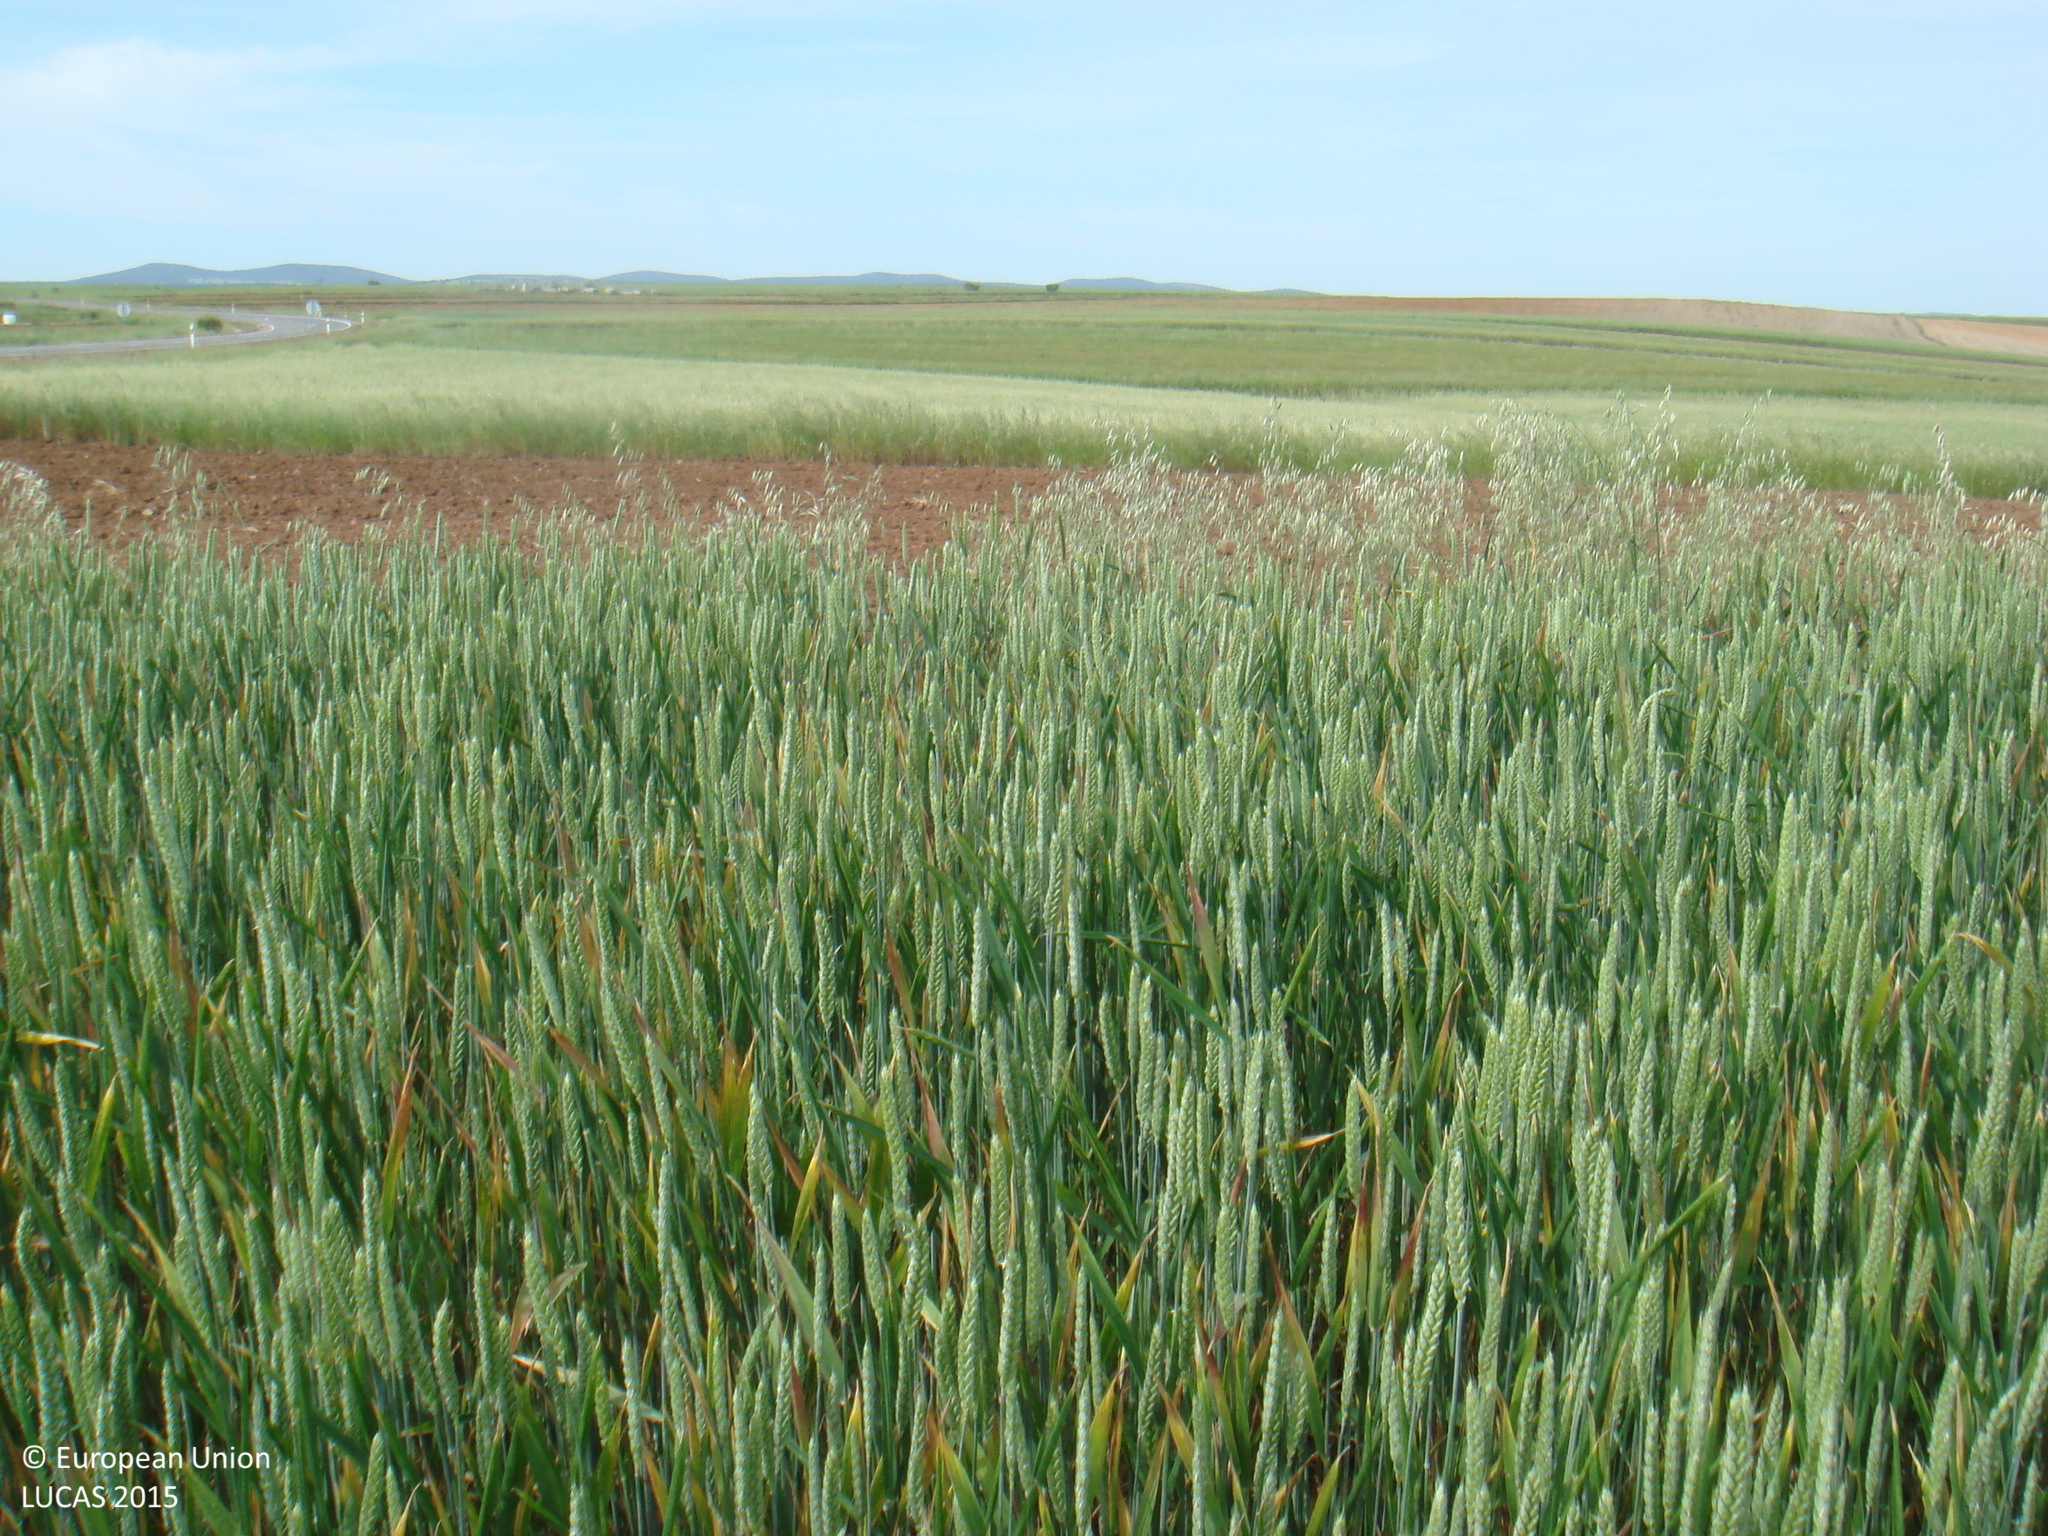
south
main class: Cropland
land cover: Common wheat
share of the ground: > 75 %
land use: Agriculture (excluding fallow land and kitchen gardens)
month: May
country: ES
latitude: 38.4591
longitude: -5.1447
